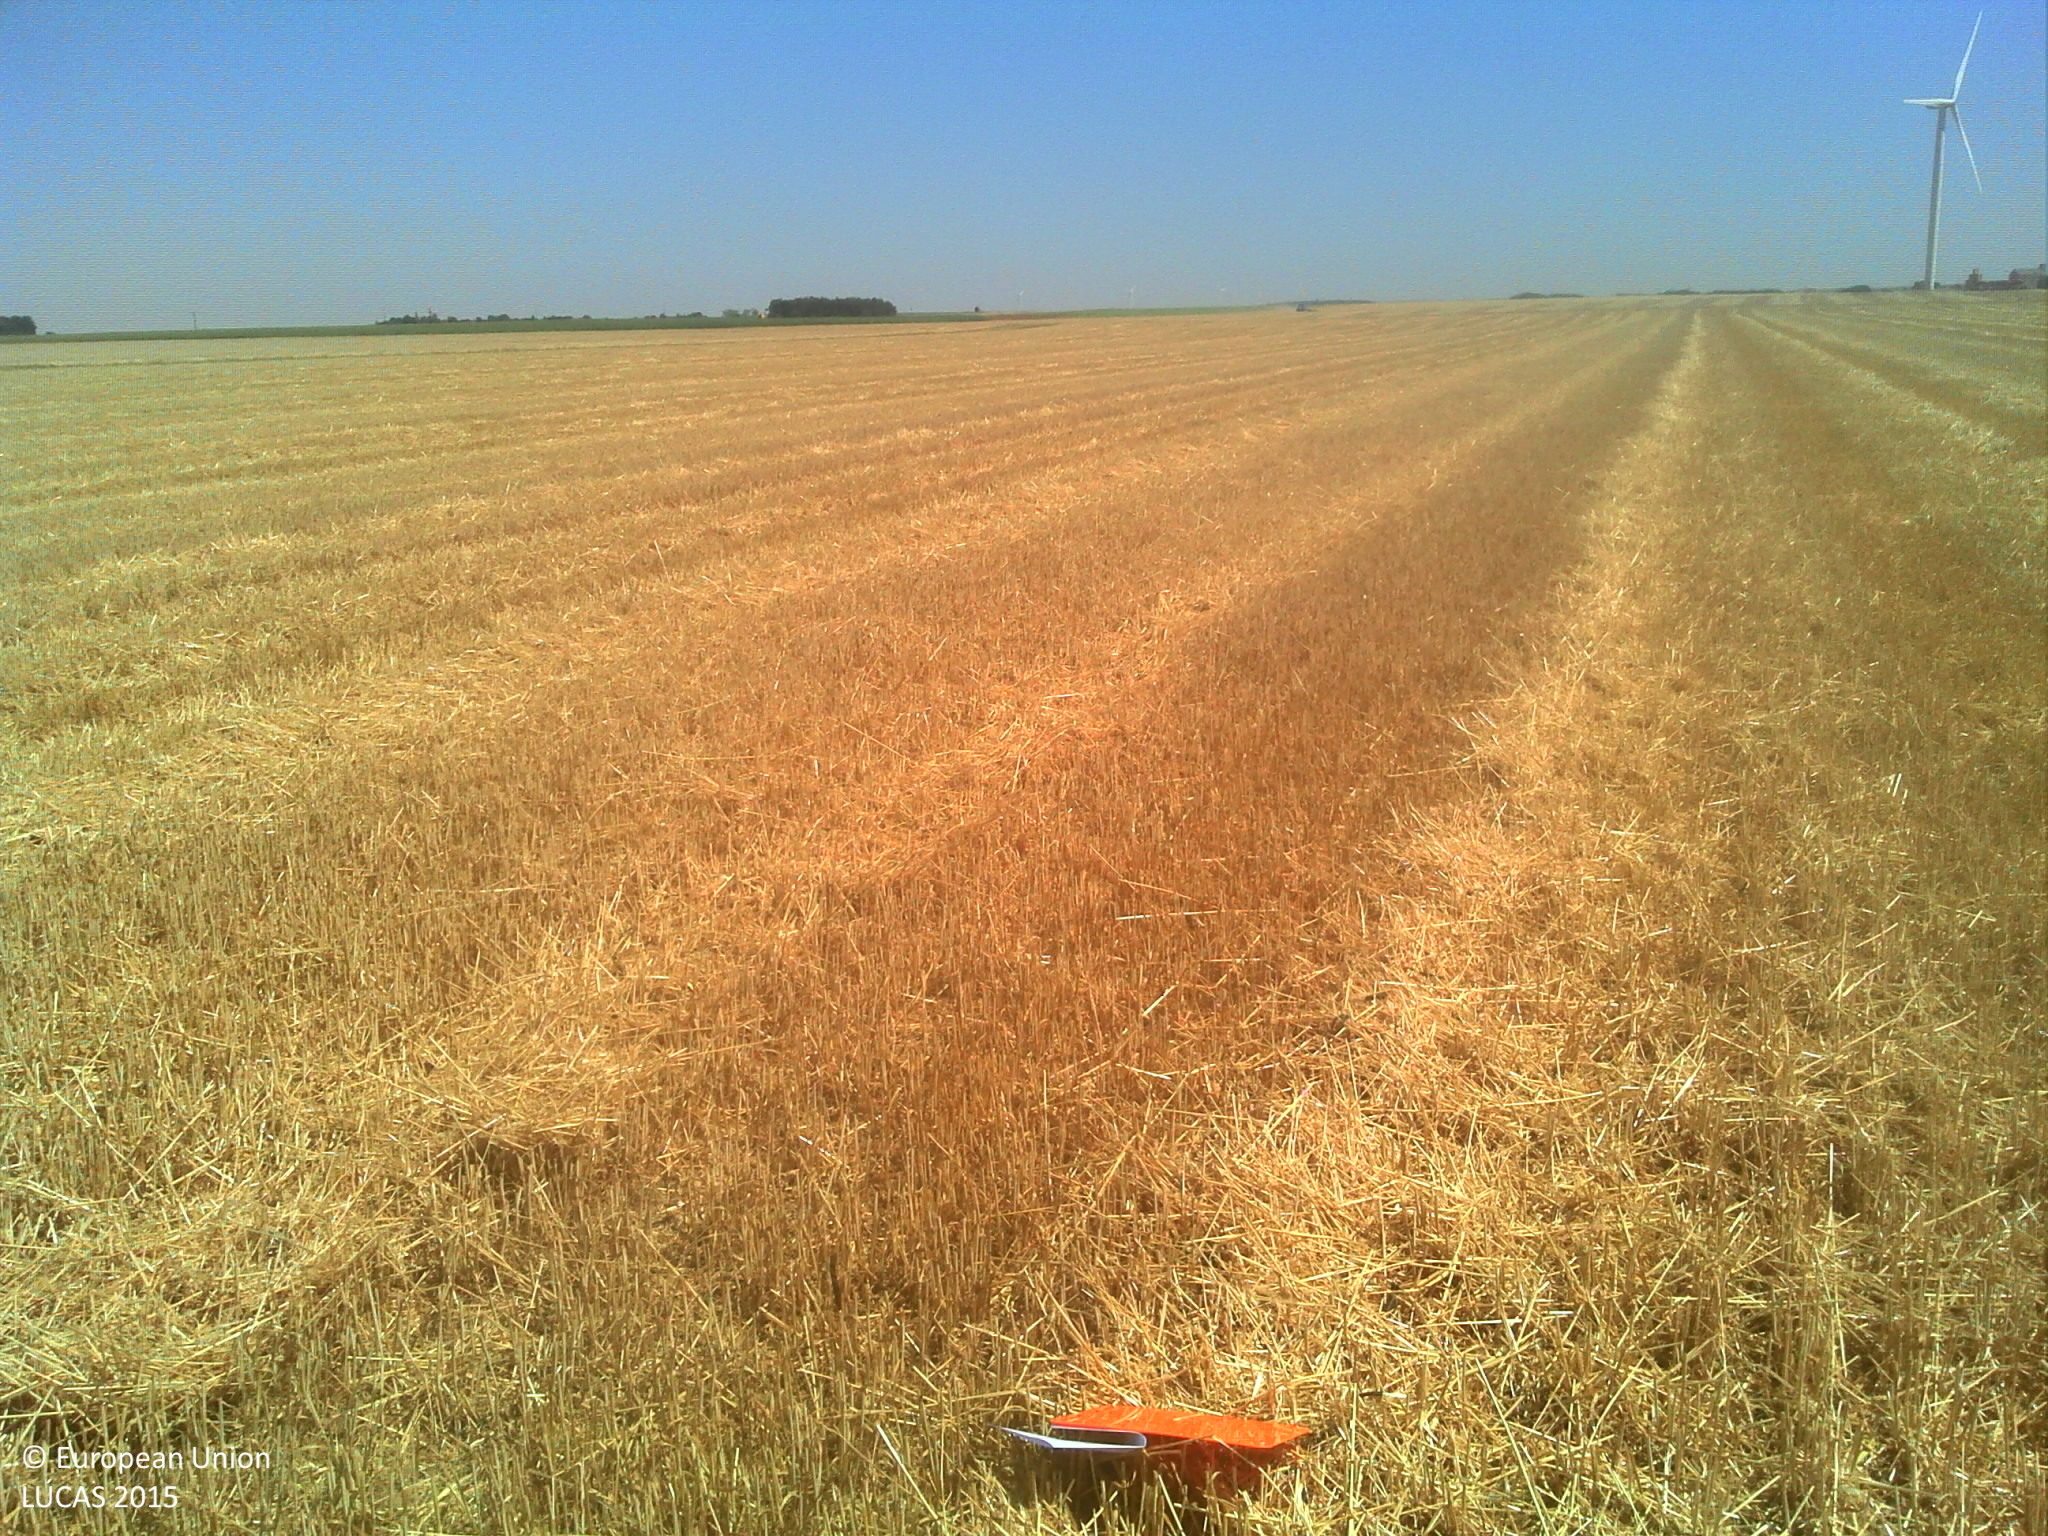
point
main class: Cropland
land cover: Durum wheat
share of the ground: > 75 %
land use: Agriculture (excluding fallow land and kitchen gardens)
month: July
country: FR
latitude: 47.9194
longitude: 1.3524
